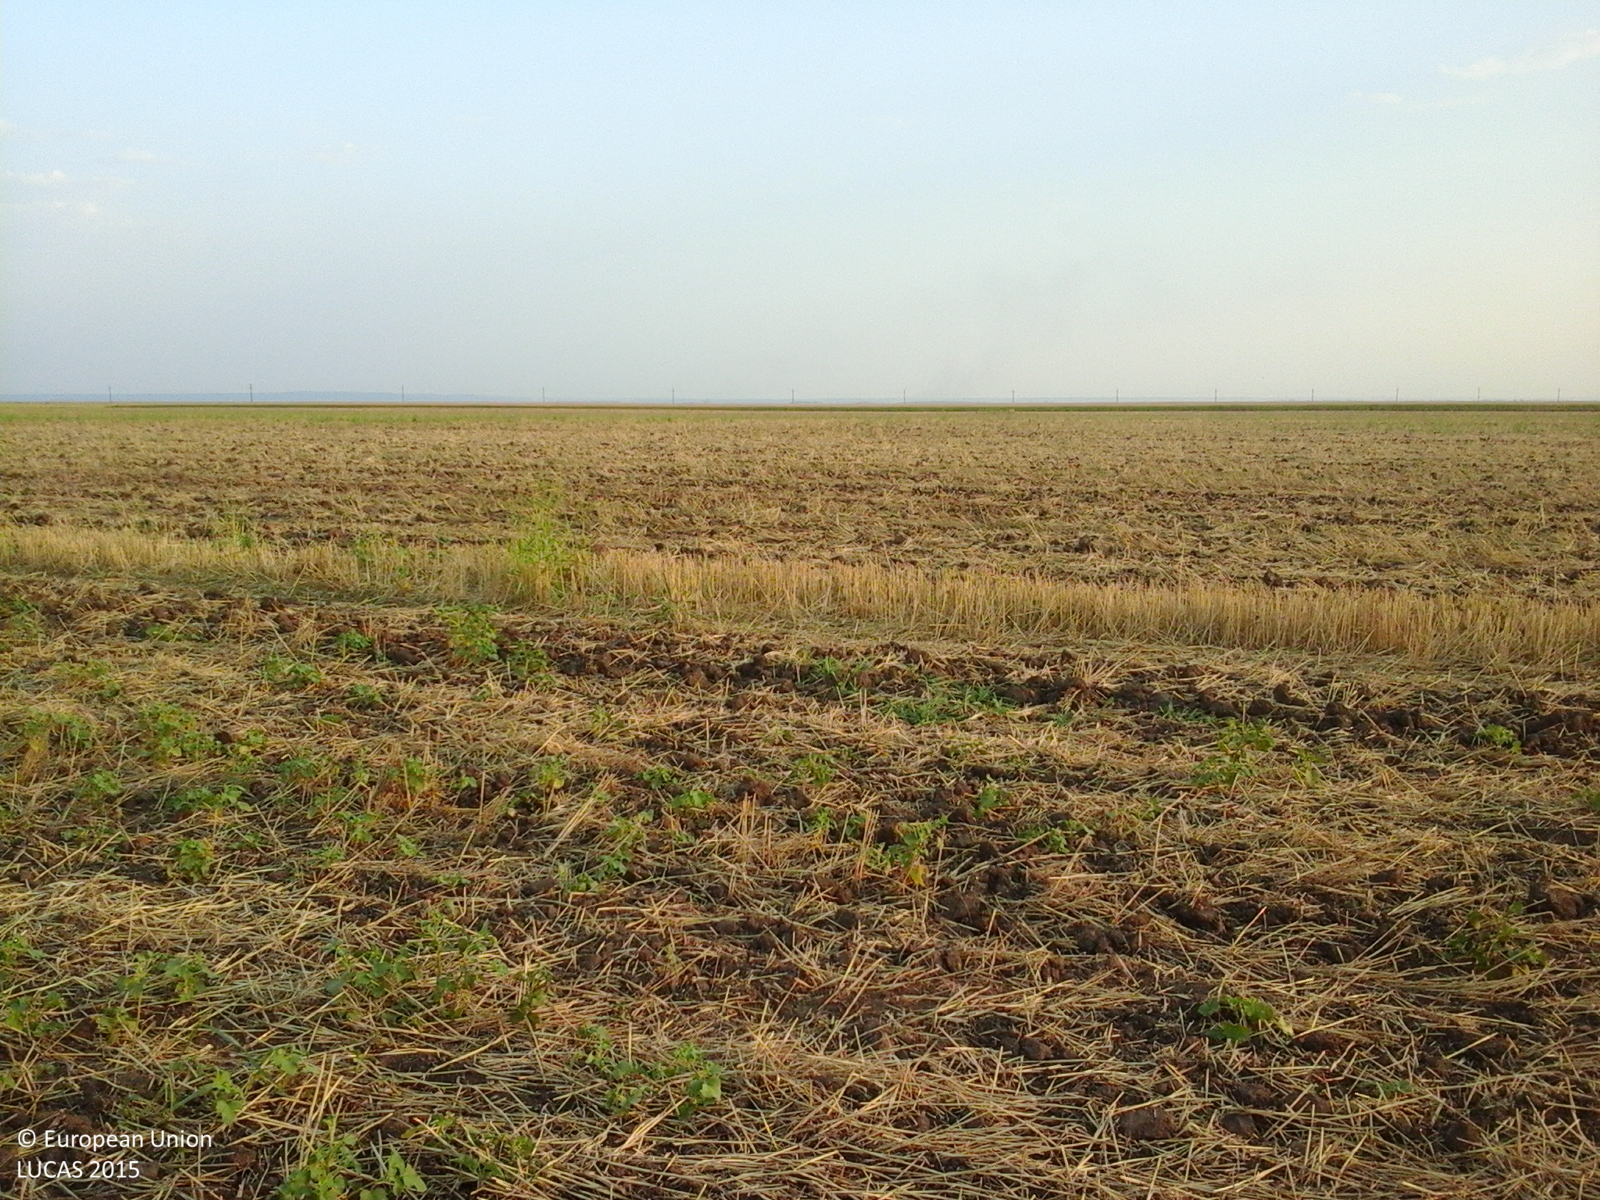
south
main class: Cropland
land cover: Common wheat
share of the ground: 50 - 75 %
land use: Agriculture (excluding fallow land and kitchen gardens)
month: August
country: RO
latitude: 44.0137
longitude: 23.2044
